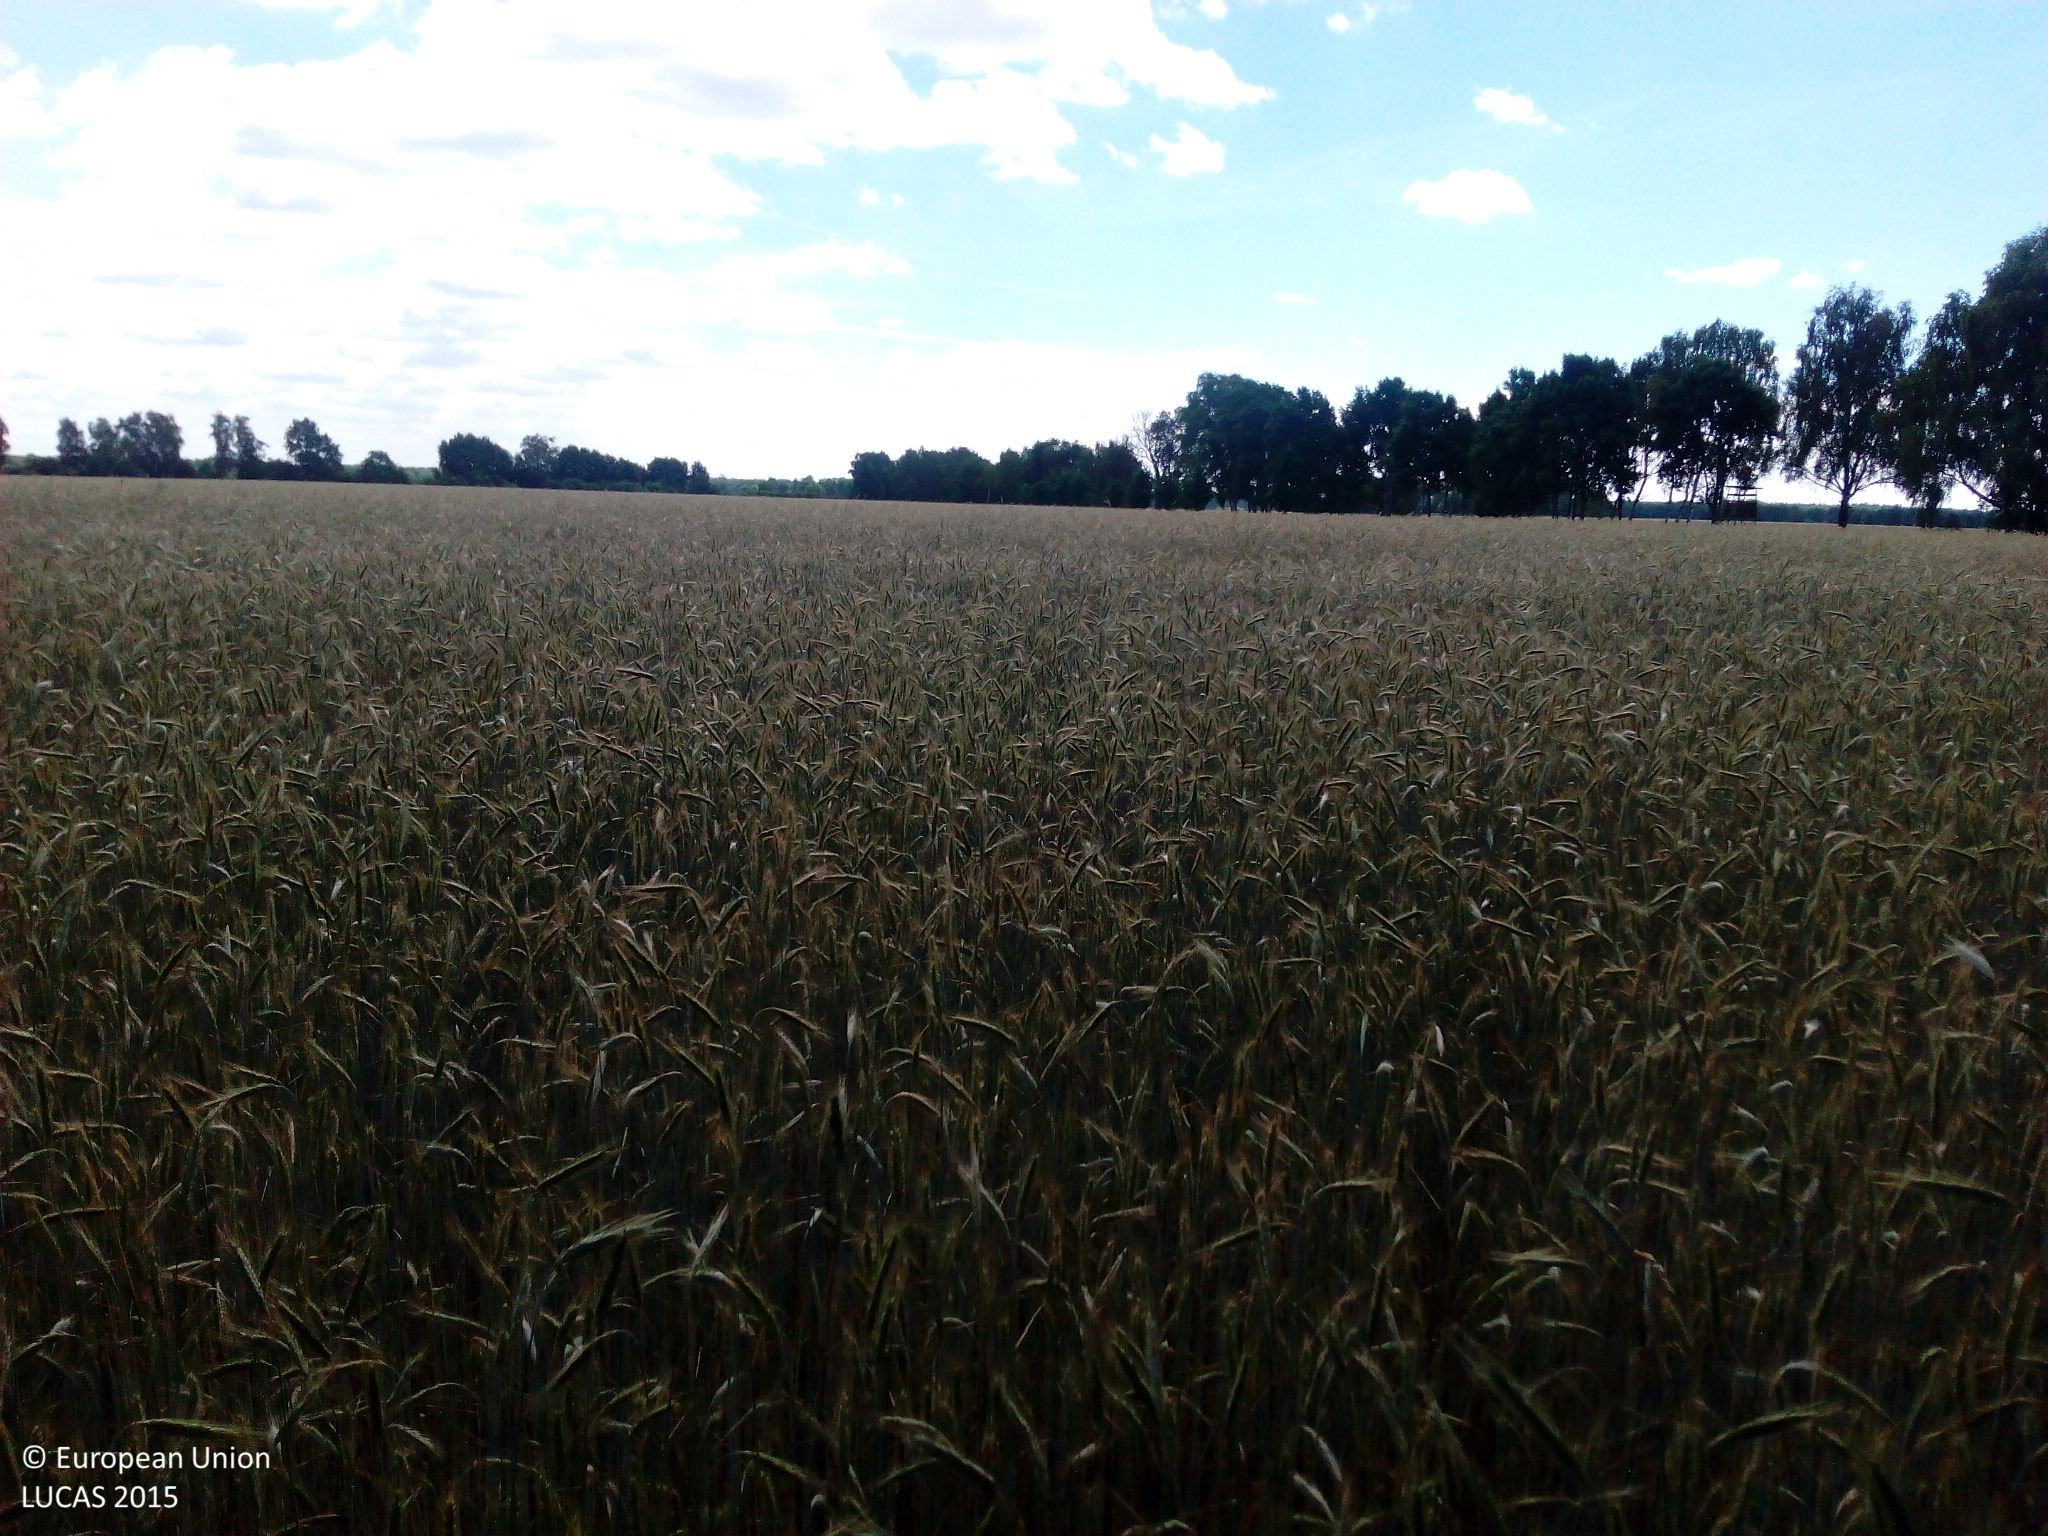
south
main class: Woodland
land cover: Broadleaved woodland
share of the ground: > 75 %
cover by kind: broadleaved forest trees 75 %, herbaceous plants 25 %
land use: Agriculture (excluding fallow land and kitchen gardens)
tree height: > 5 m
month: June
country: DE
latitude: 52.8211
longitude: 13.1606
